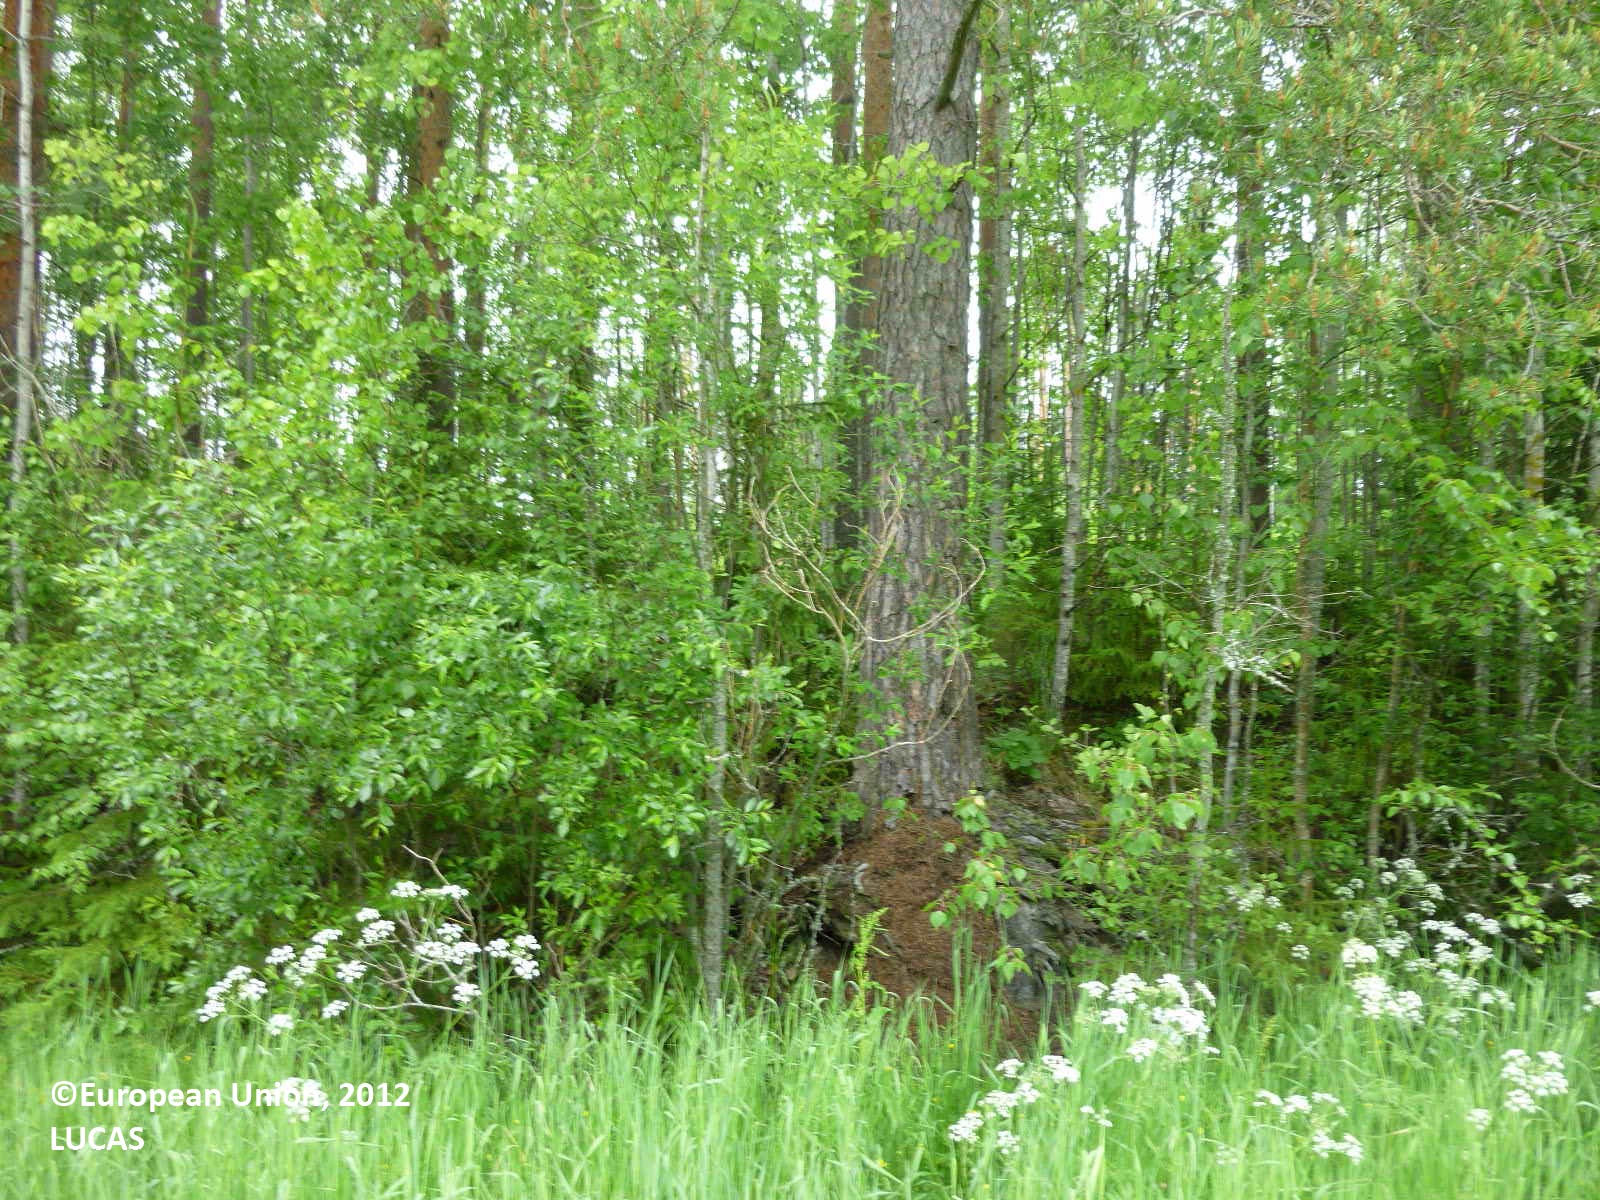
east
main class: Grassland
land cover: Grassland without tree/shrub cover
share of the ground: > 75 %
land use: Fallow land
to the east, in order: Grassland without tree/shrub cover; Ditches and canals; Spruce dominated mixed woodland; Ditches and canals; Grassland without tree/shrub cover; Electric lines; Grassland without tree/shrub cover; Abandoned hedges; Ditches and canals; Grassland without tree/shrub cover; Paved roads, cycling and walking lanes
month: June
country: FI
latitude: 61.6530
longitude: 22.4656
